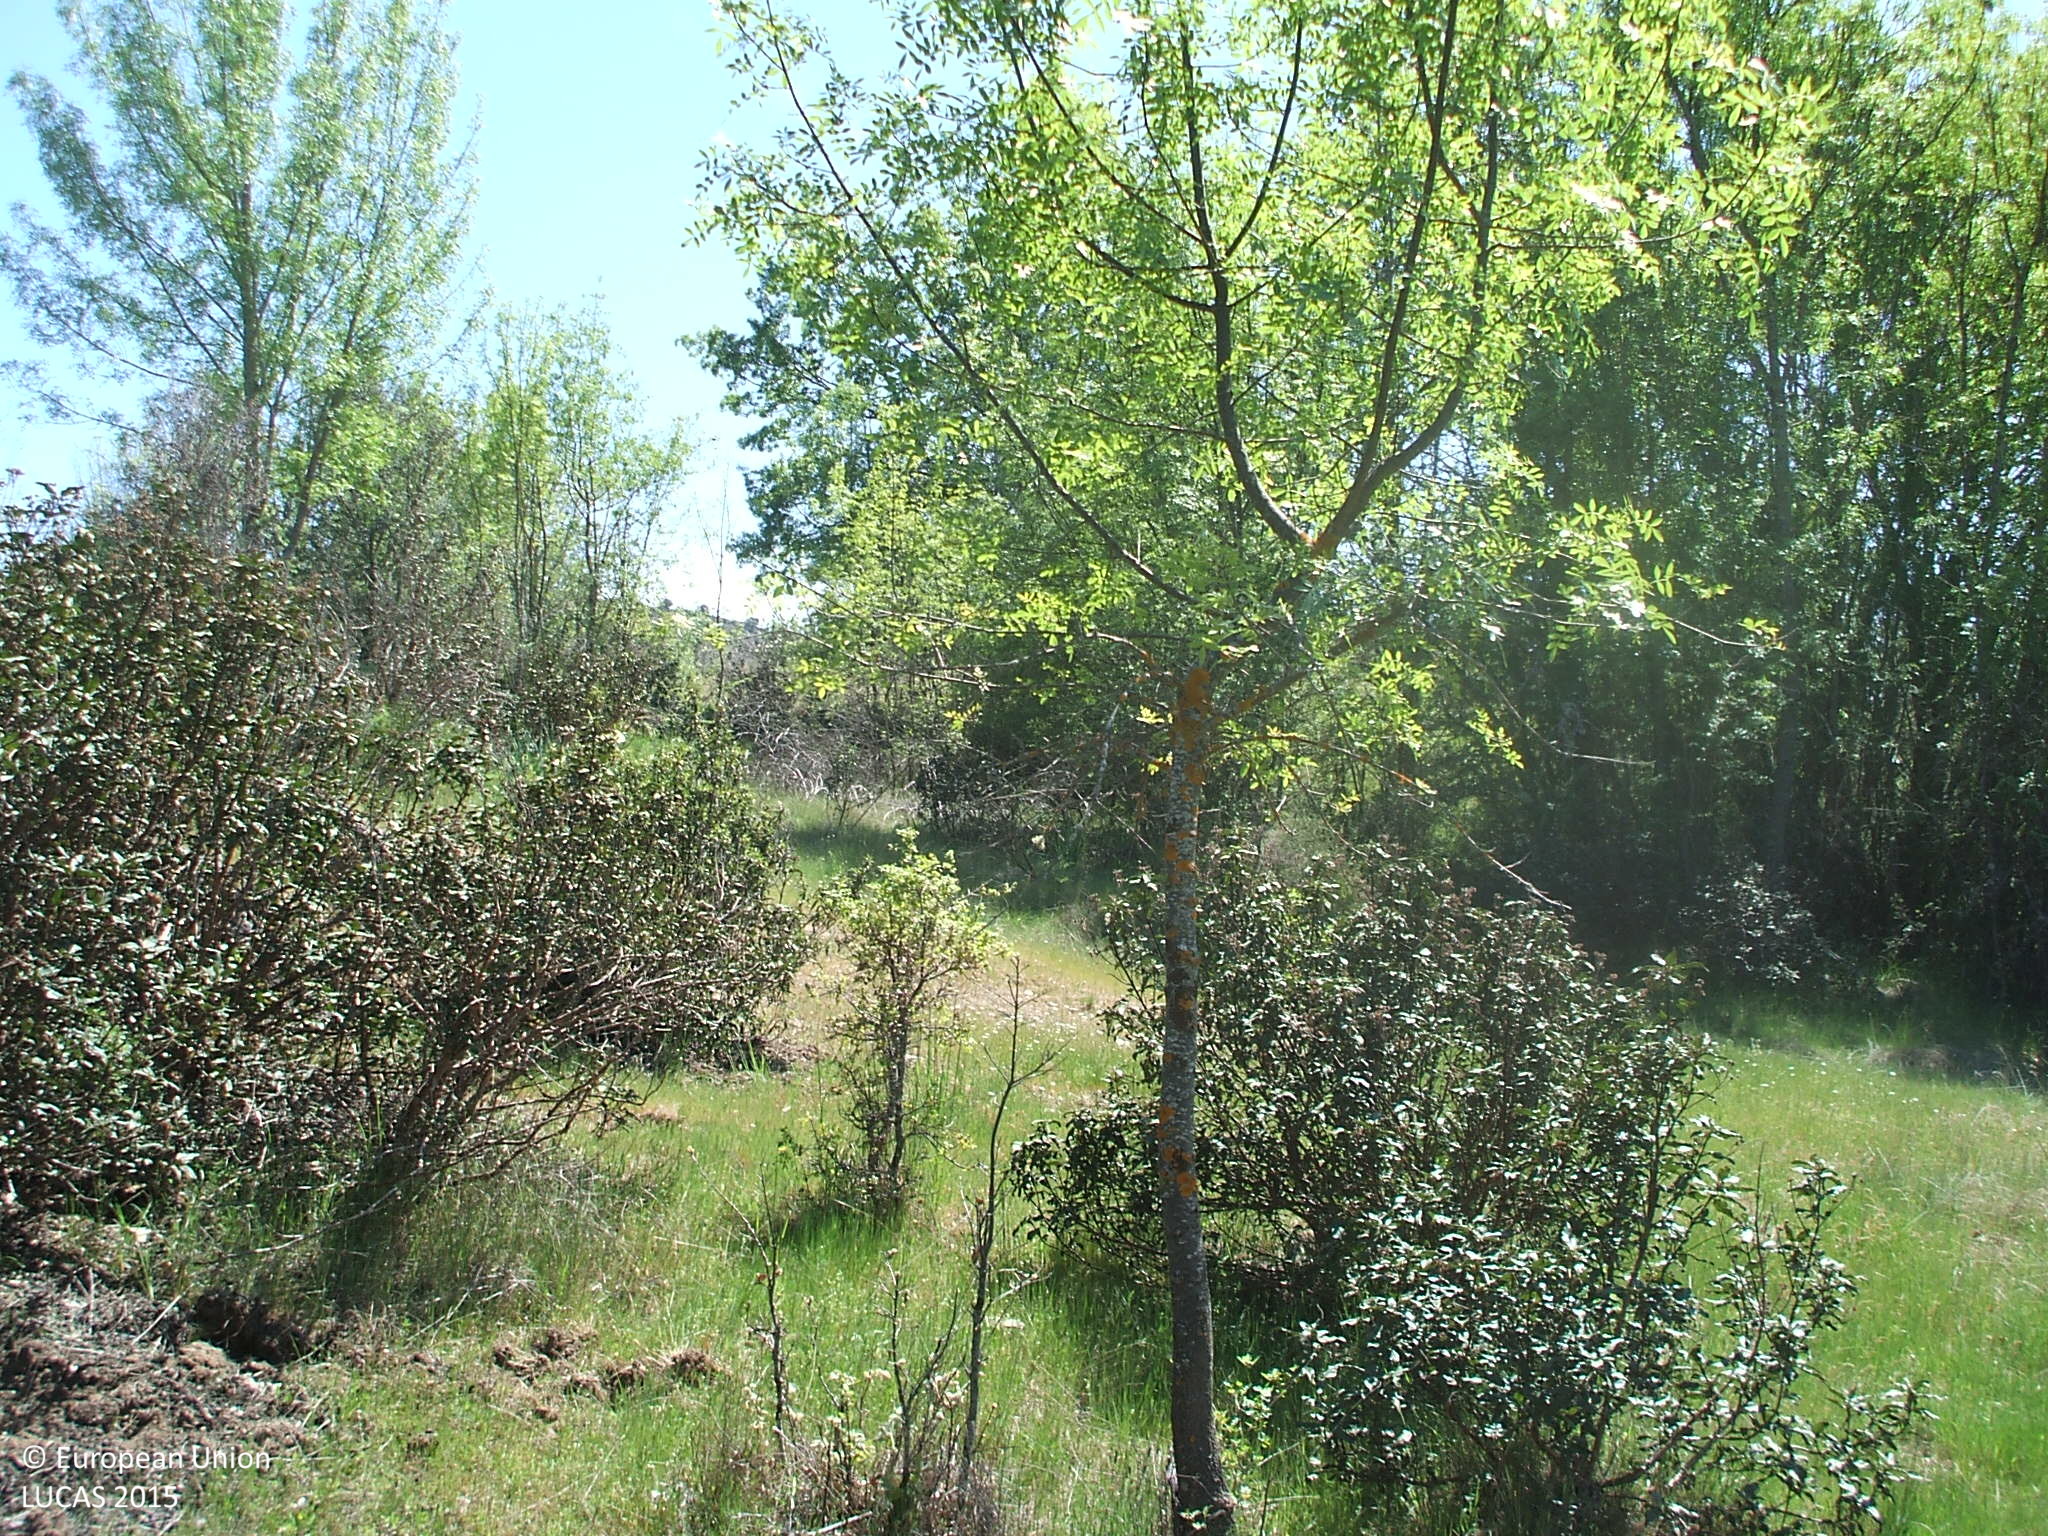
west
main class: Grassland
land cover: Grassland with sparse tree/shrub cover
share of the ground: > 75 %
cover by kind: herbaceous plants 90 %, broadleaved forest trees 5 %, shrubs 5 %
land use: Semi-natural and natural areas not in use
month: May
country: ES
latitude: 41.0249
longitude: -3.0114
